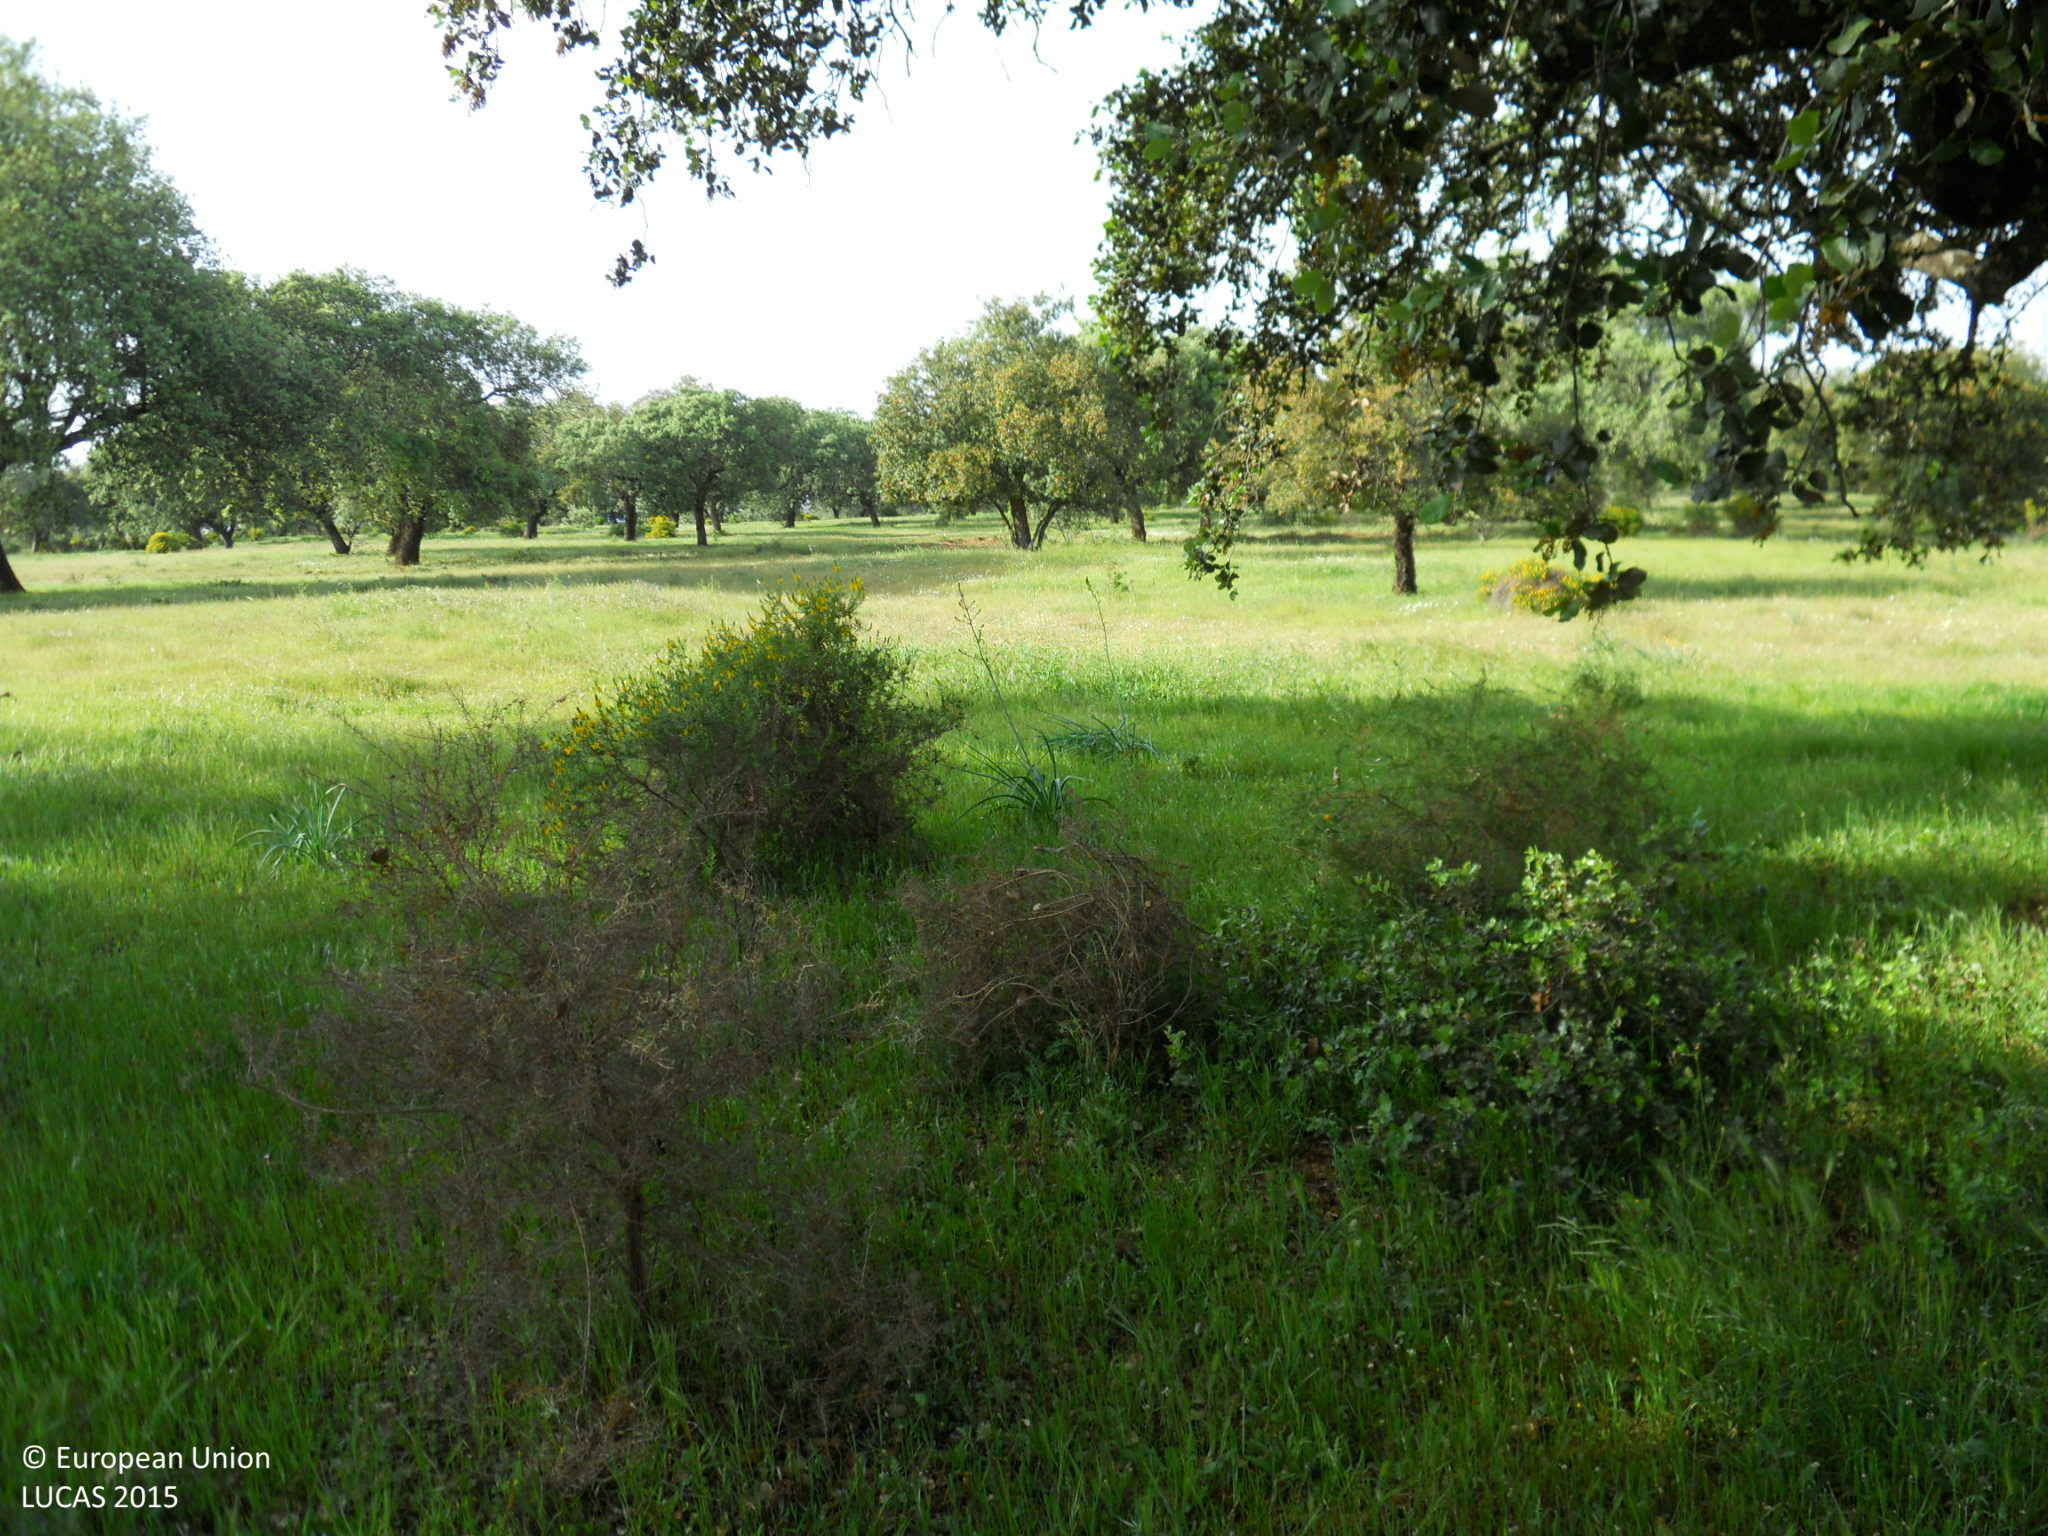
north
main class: Woodland
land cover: Broadleaved woodland
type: broadleaved evergreen forest
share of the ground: 50 - 75 %
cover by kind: broadleaved forest trees 50 %, herbaceous plants 50 %
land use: Forestry
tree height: > 5 m
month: April
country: ES
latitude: 39.0994
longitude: -6.2824
